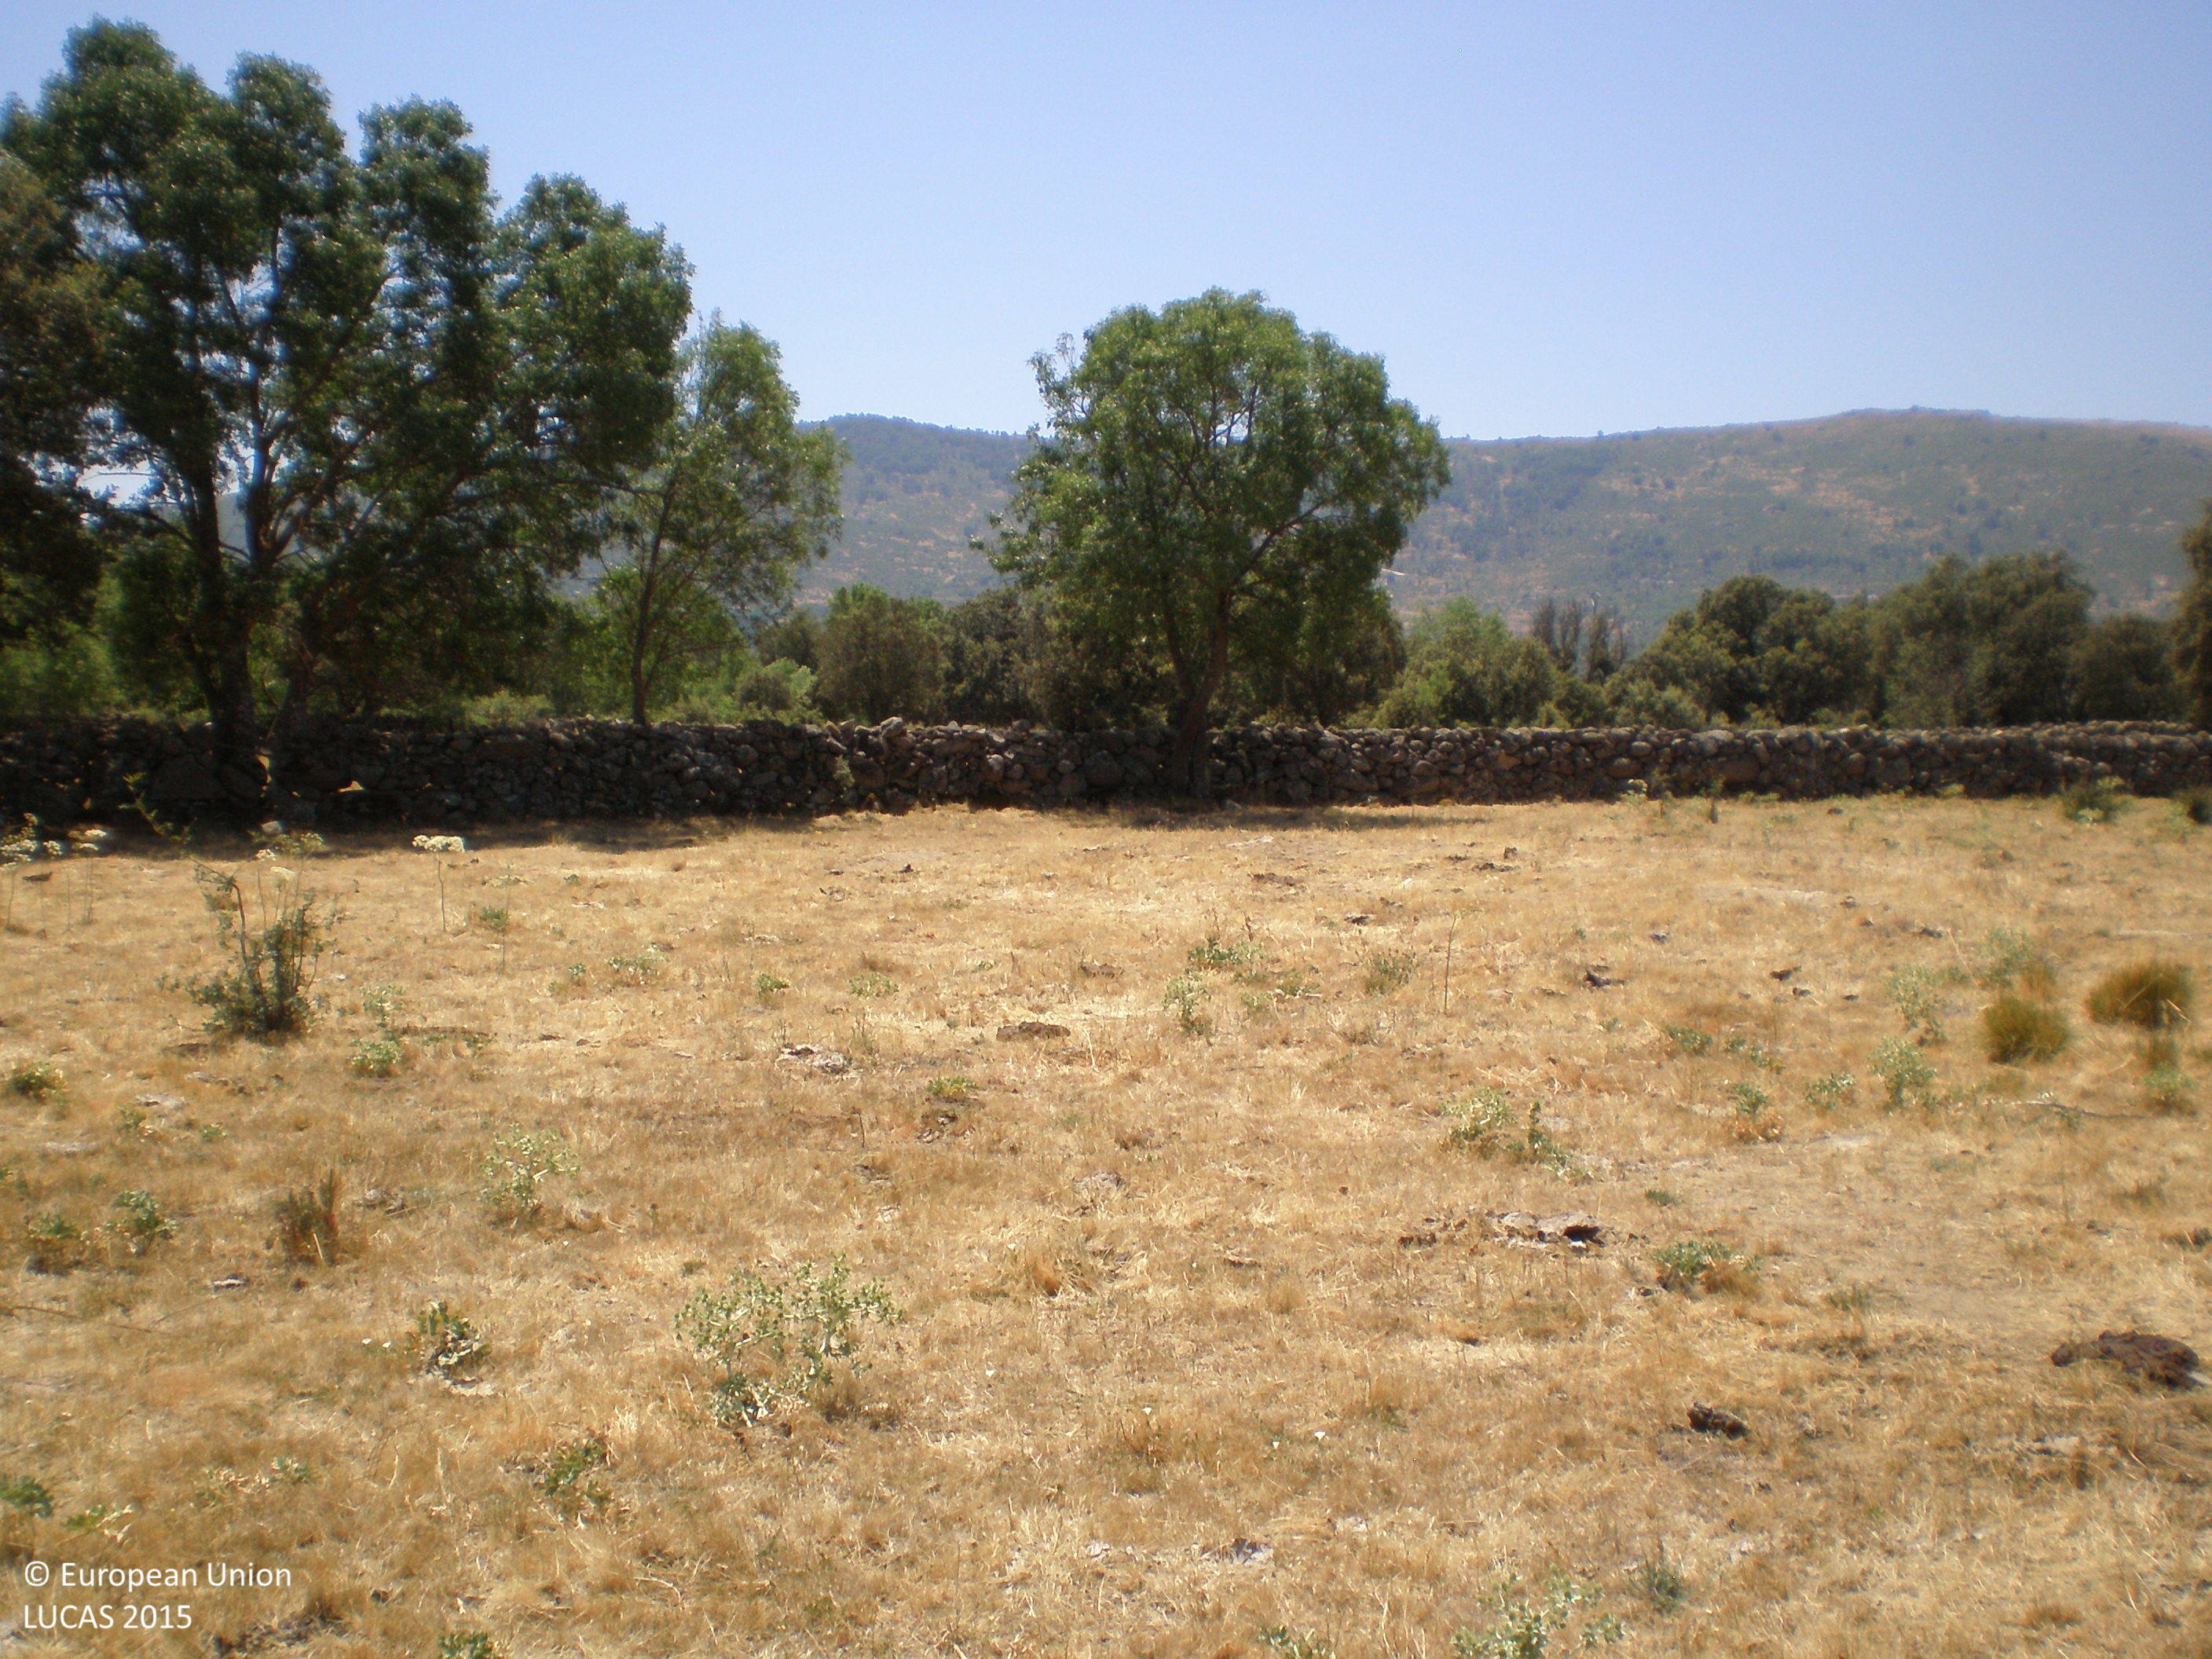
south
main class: Grassland
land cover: Grassland with sparse tree/shrub cover
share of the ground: > 75 %
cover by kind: herbaceous plants 95 %, broadleaved forest trees 5 %
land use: Agriculture (excluding fallow land and kitchen gardens)
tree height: < 5 m
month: July
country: ES
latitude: 40.4137
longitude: -5.5641
